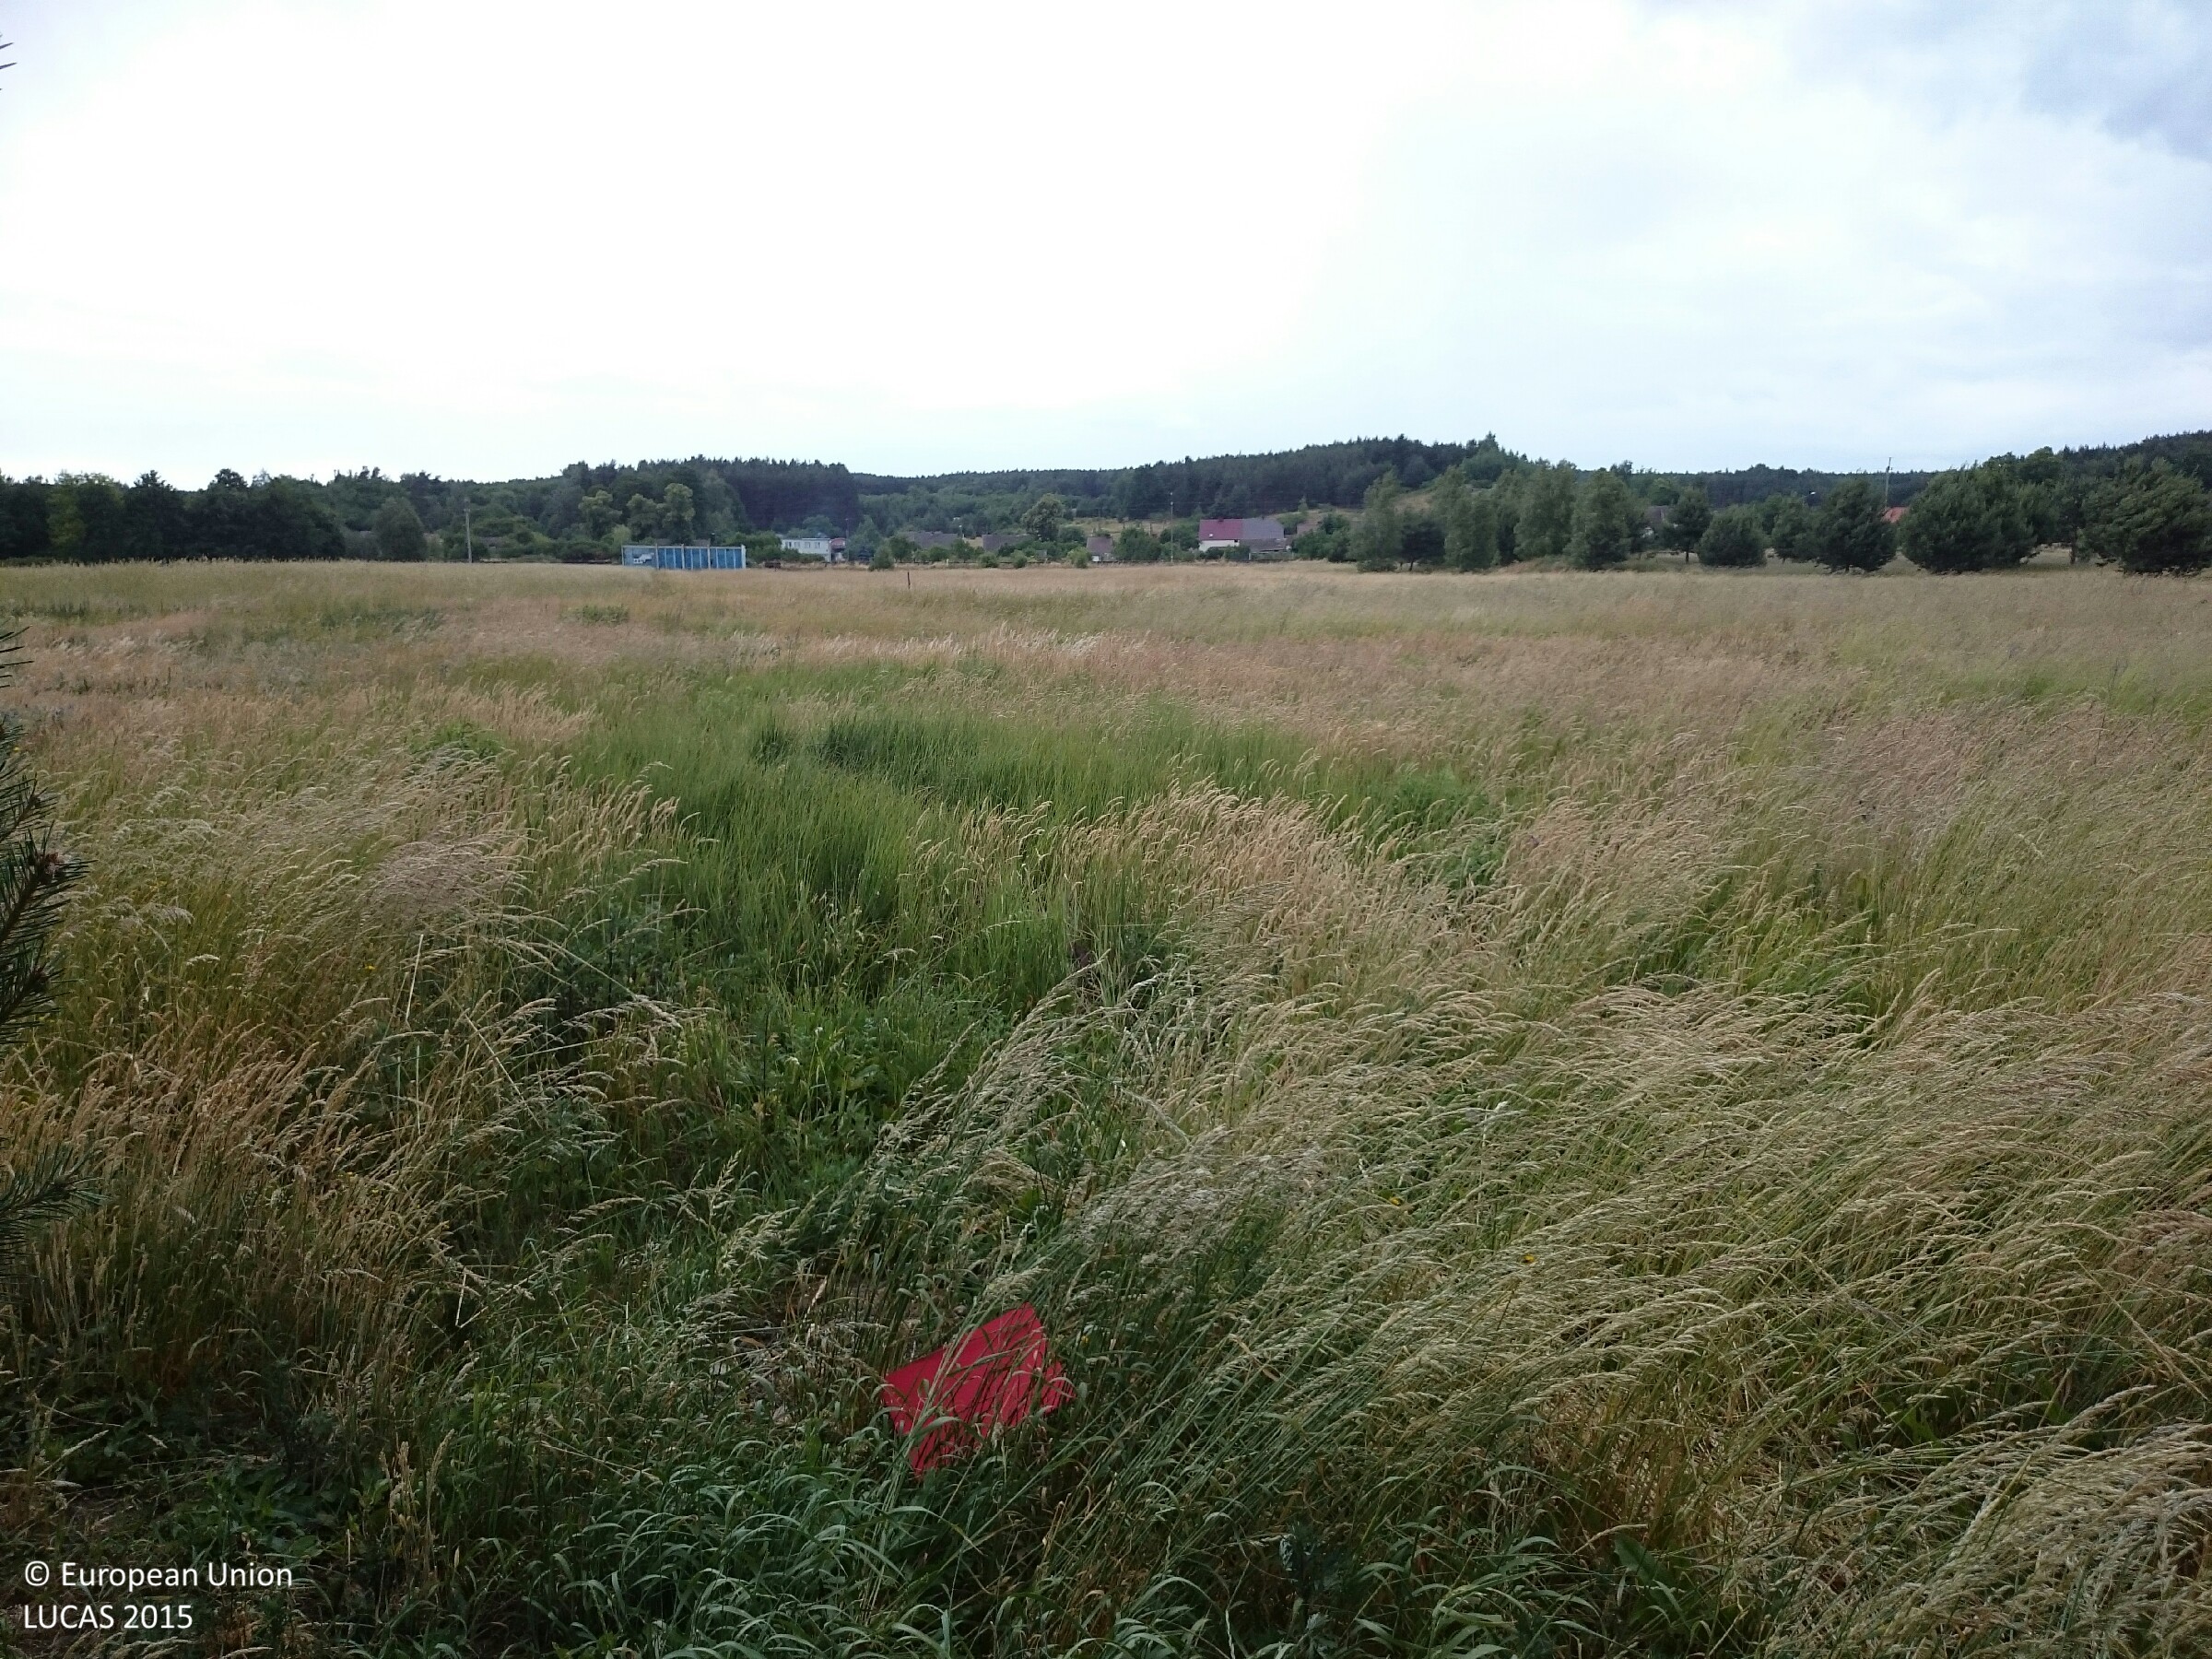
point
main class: Grassland
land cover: Spontaneously vegetated surfaces
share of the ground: > 75 %
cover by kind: herbaceous plants 95 %, shrubs 5 %
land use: Fallow land
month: June
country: PL
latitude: 52.8537
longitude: 15.6920
